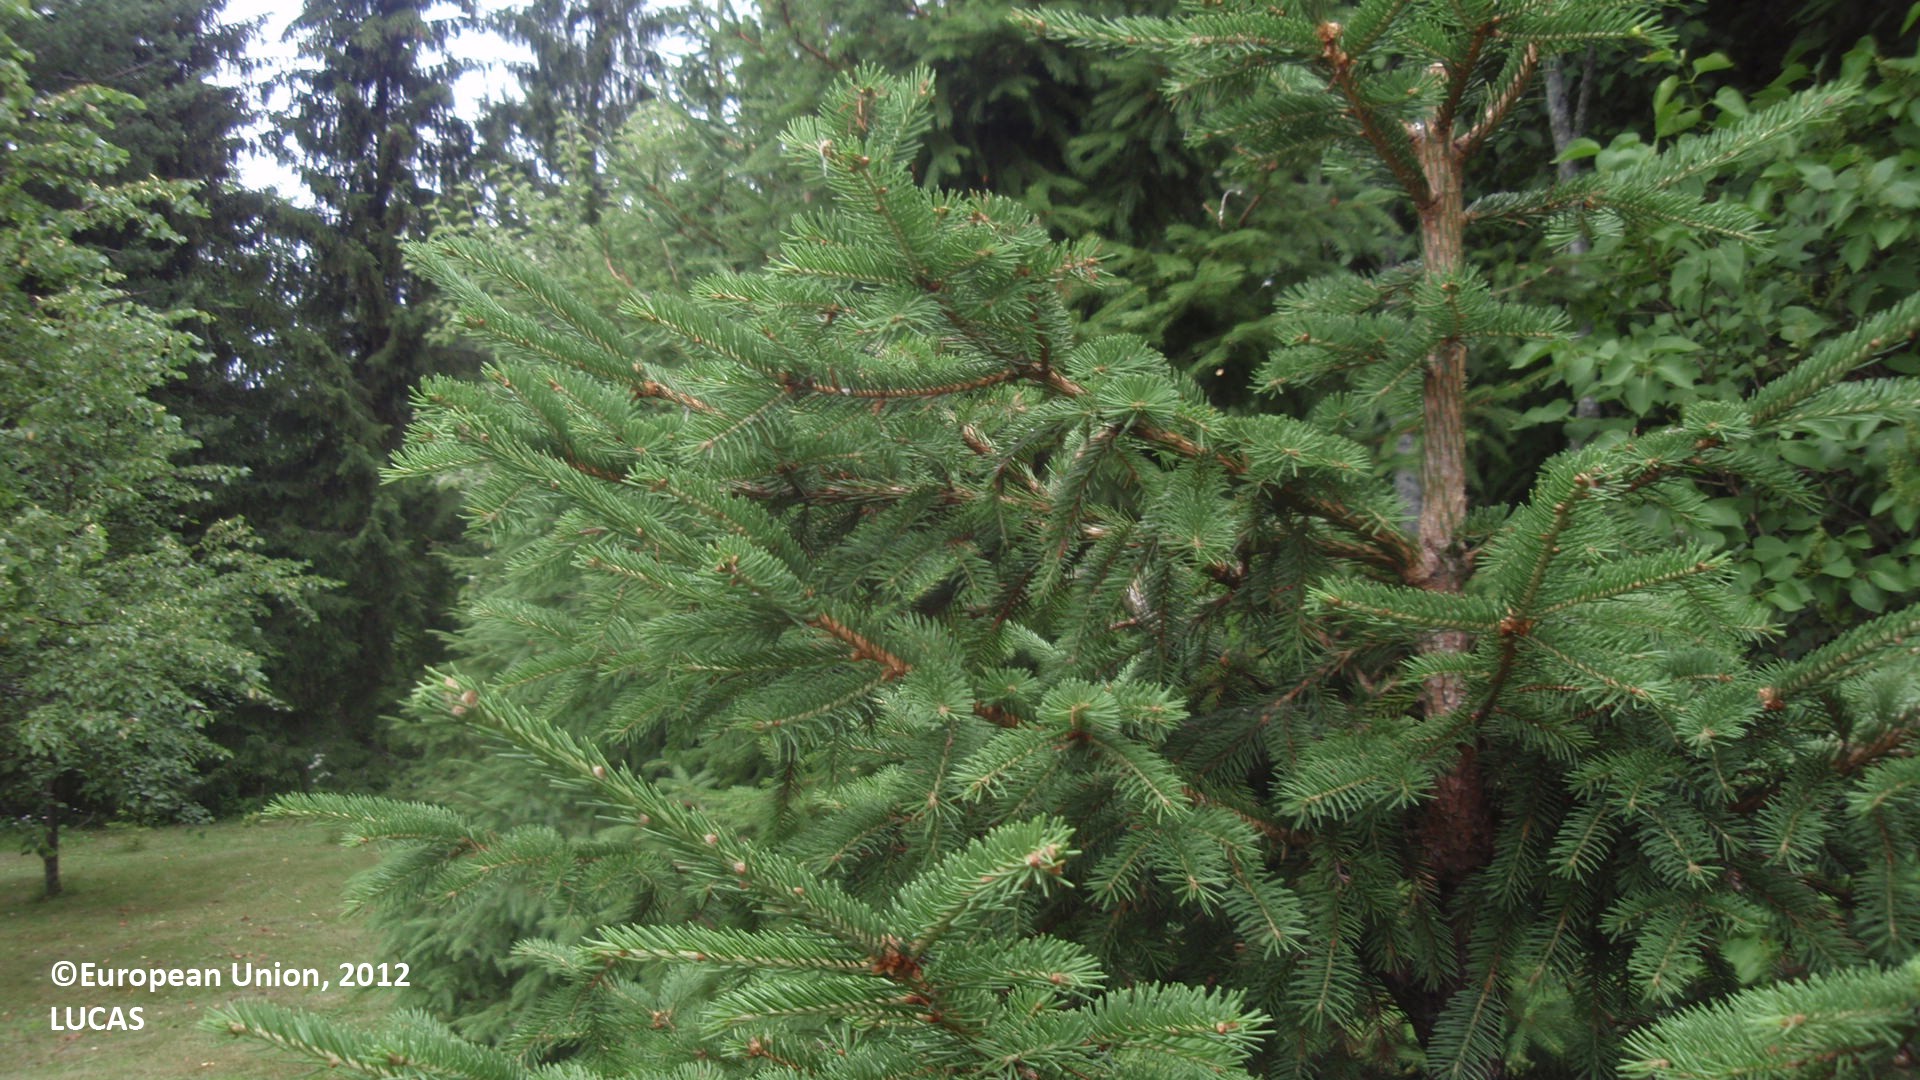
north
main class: Grassland
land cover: Grassland with sparse tree/shrub cover
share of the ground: > 75 %
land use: Residential
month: July
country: FI
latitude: 61.1850
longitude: 28.8069
